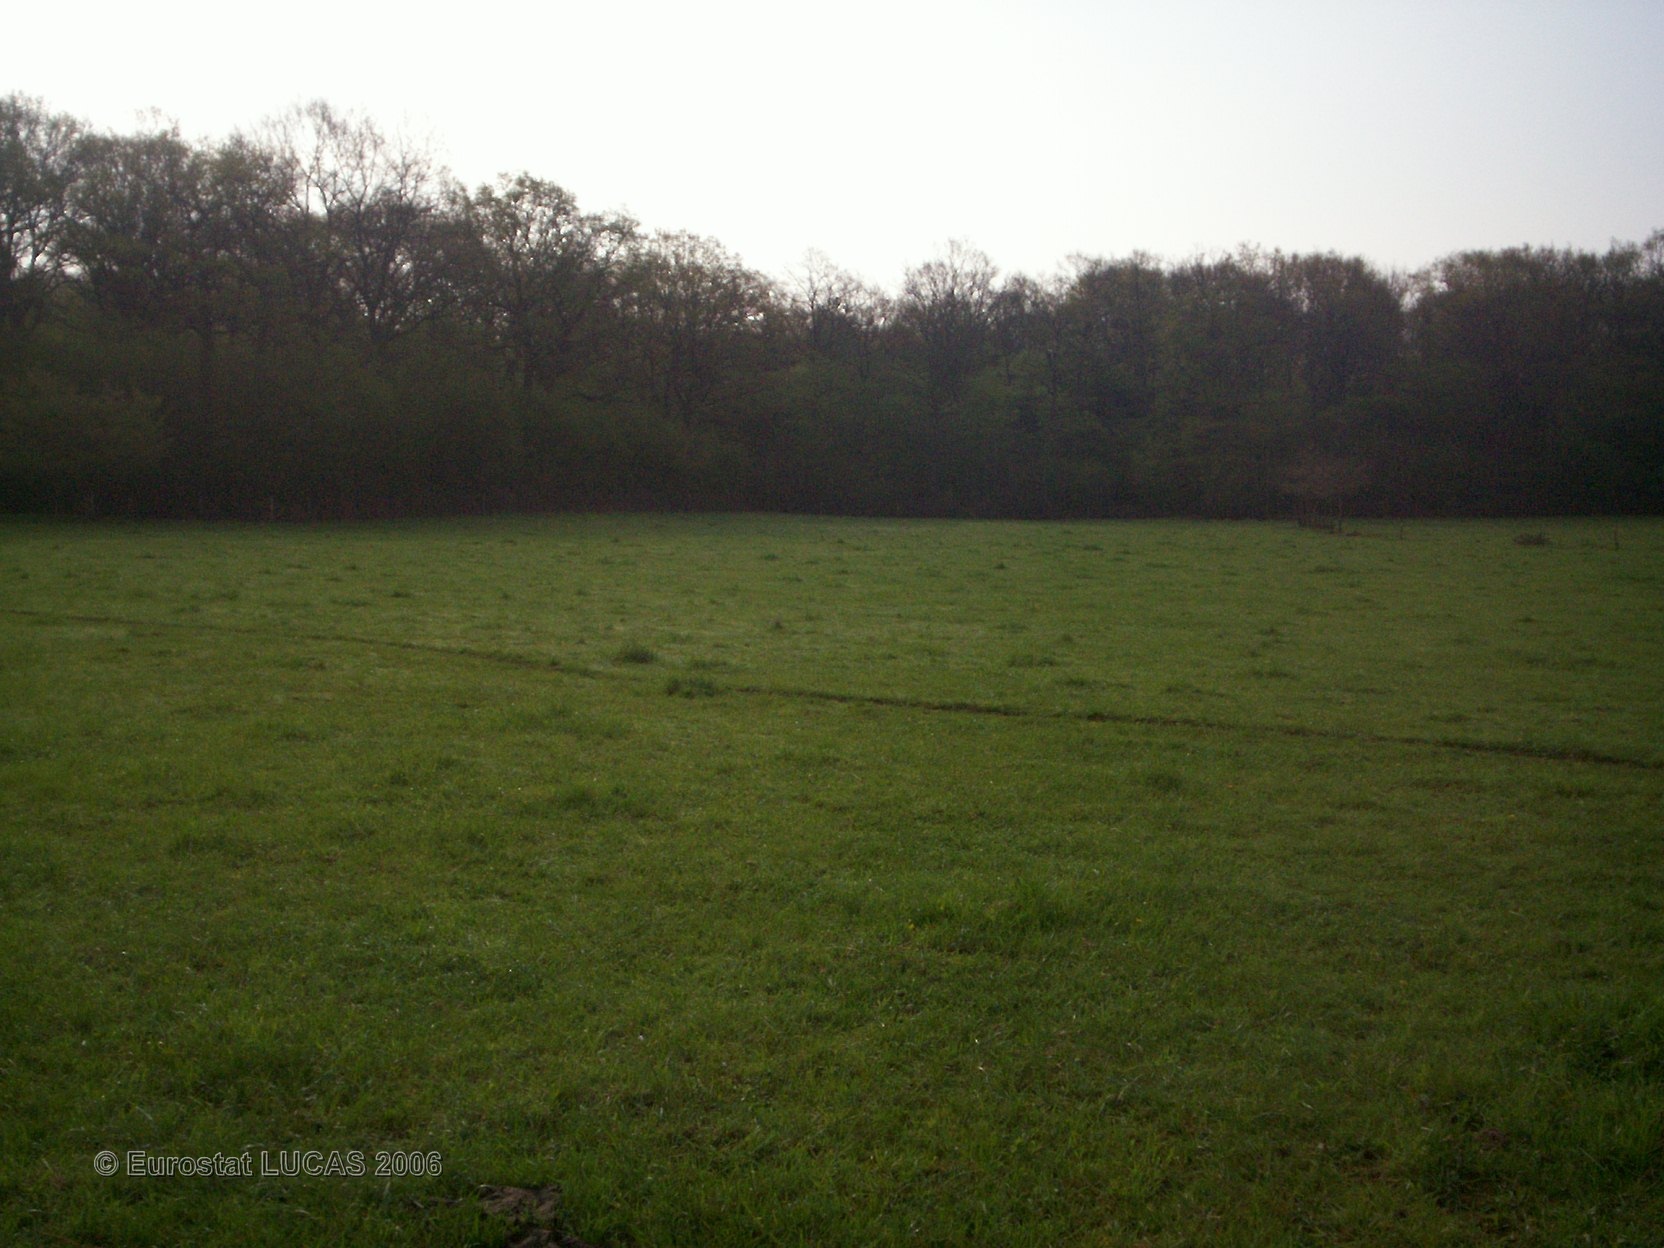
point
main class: Grassland
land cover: Grassland without tree/shrub cover
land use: Agriculture (excluding fallow land and kitchen gardens)
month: April
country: FR
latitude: 47.2119
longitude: 3.0901
